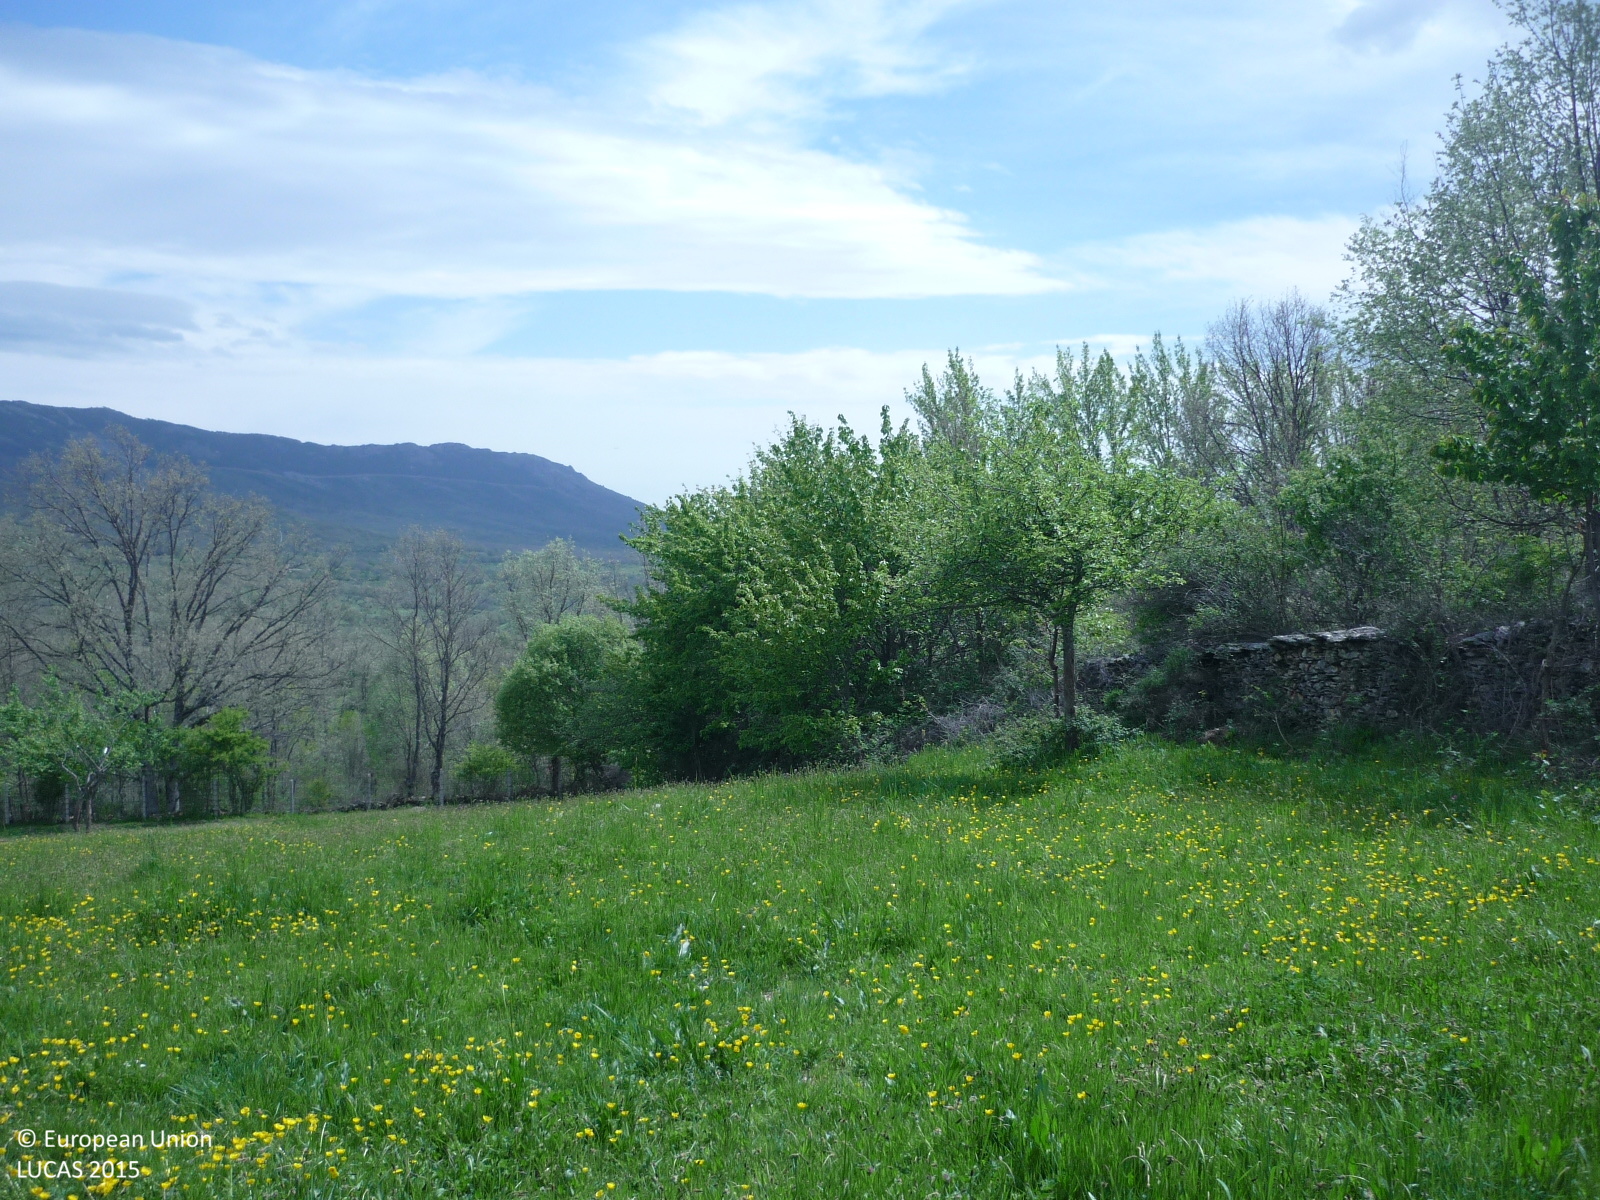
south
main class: Shrubland
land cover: Shrubland with sparse tree cover
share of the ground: > 75 %
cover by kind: shrubs 85 %, herbaceous plants 10 %, broadleaved forest trees 5 %
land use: Semi-natural and natural areas not in use
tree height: < 5 m
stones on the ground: < 10 %
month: May
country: ES
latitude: 41.0862
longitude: -3.5067
